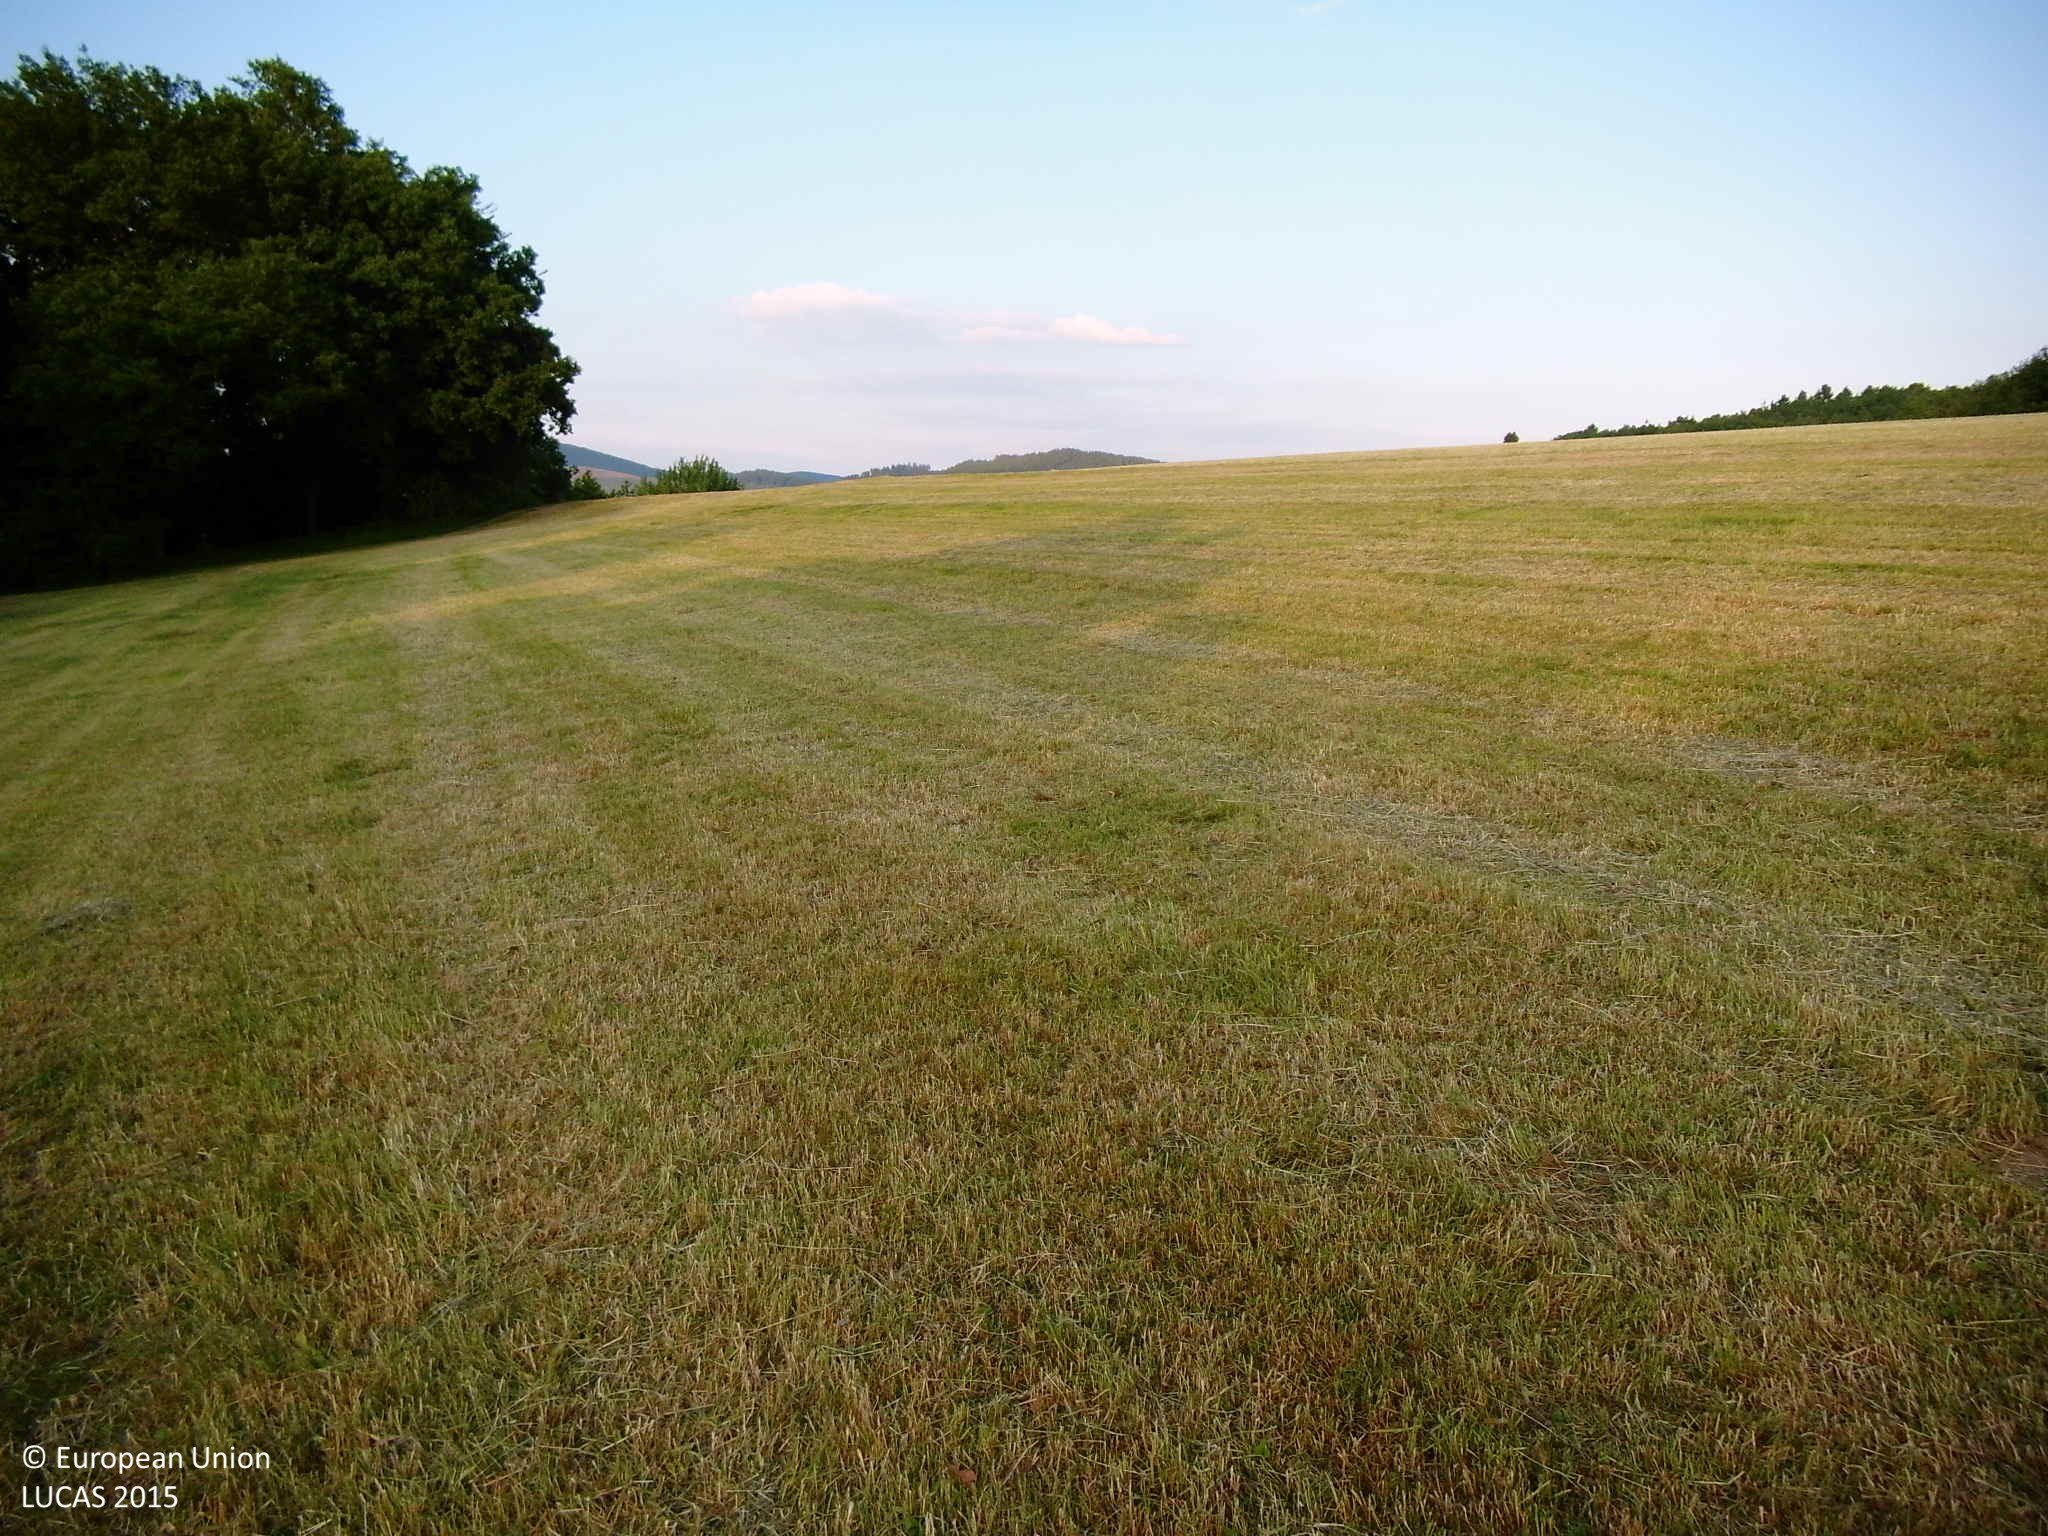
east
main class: Grassland
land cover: Grassland without tree/shrub cover
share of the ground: > 75 %
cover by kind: herbaceous plants 100 %
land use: Agriculture (excluding fallow land and kitchen gardens)
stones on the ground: 10 - 25 %
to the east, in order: Grassland without tree/shrub cover; Shrubland with sparse tree cover; Fences; Broadleaved woodland; Grassland without tree/shrub cover
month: June
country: DE
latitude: 50.9235
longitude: 8.0798
